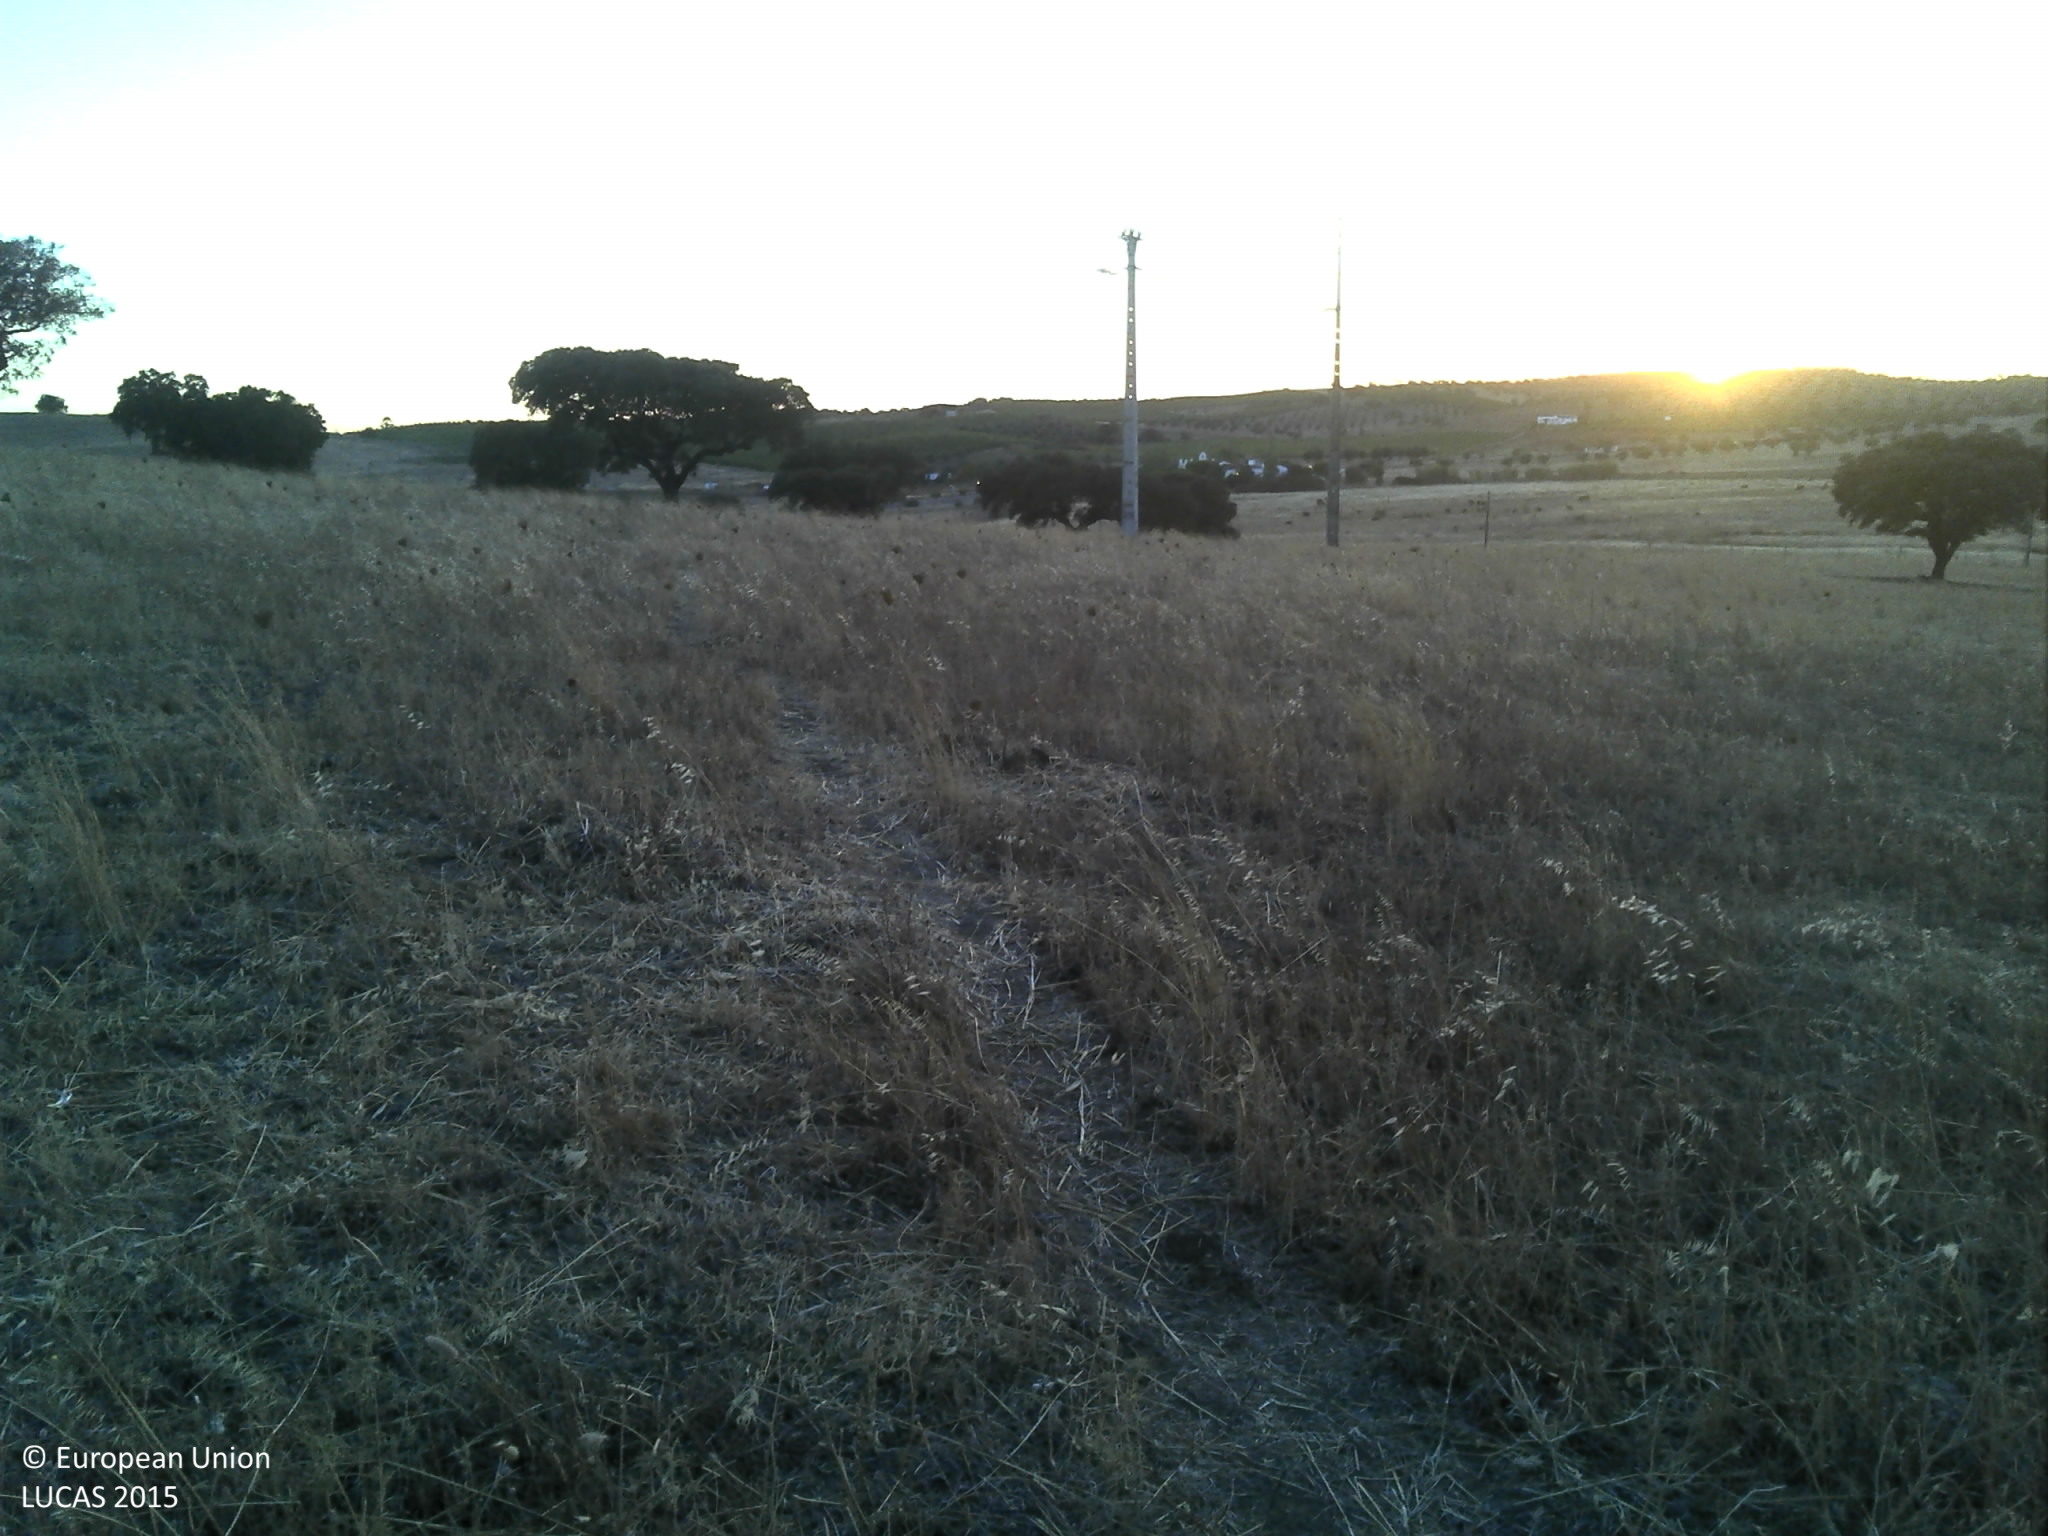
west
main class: Grassland
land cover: Grassland without tree/shrub cover
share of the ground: 50 - 75 %
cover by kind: herbaceous plants 60 %, unconsolidated bare surface 40 %
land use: Agriculture (excluding fallow land and kitchen gardens)
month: July
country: PT
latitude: 38.2338
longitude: -7.9123
